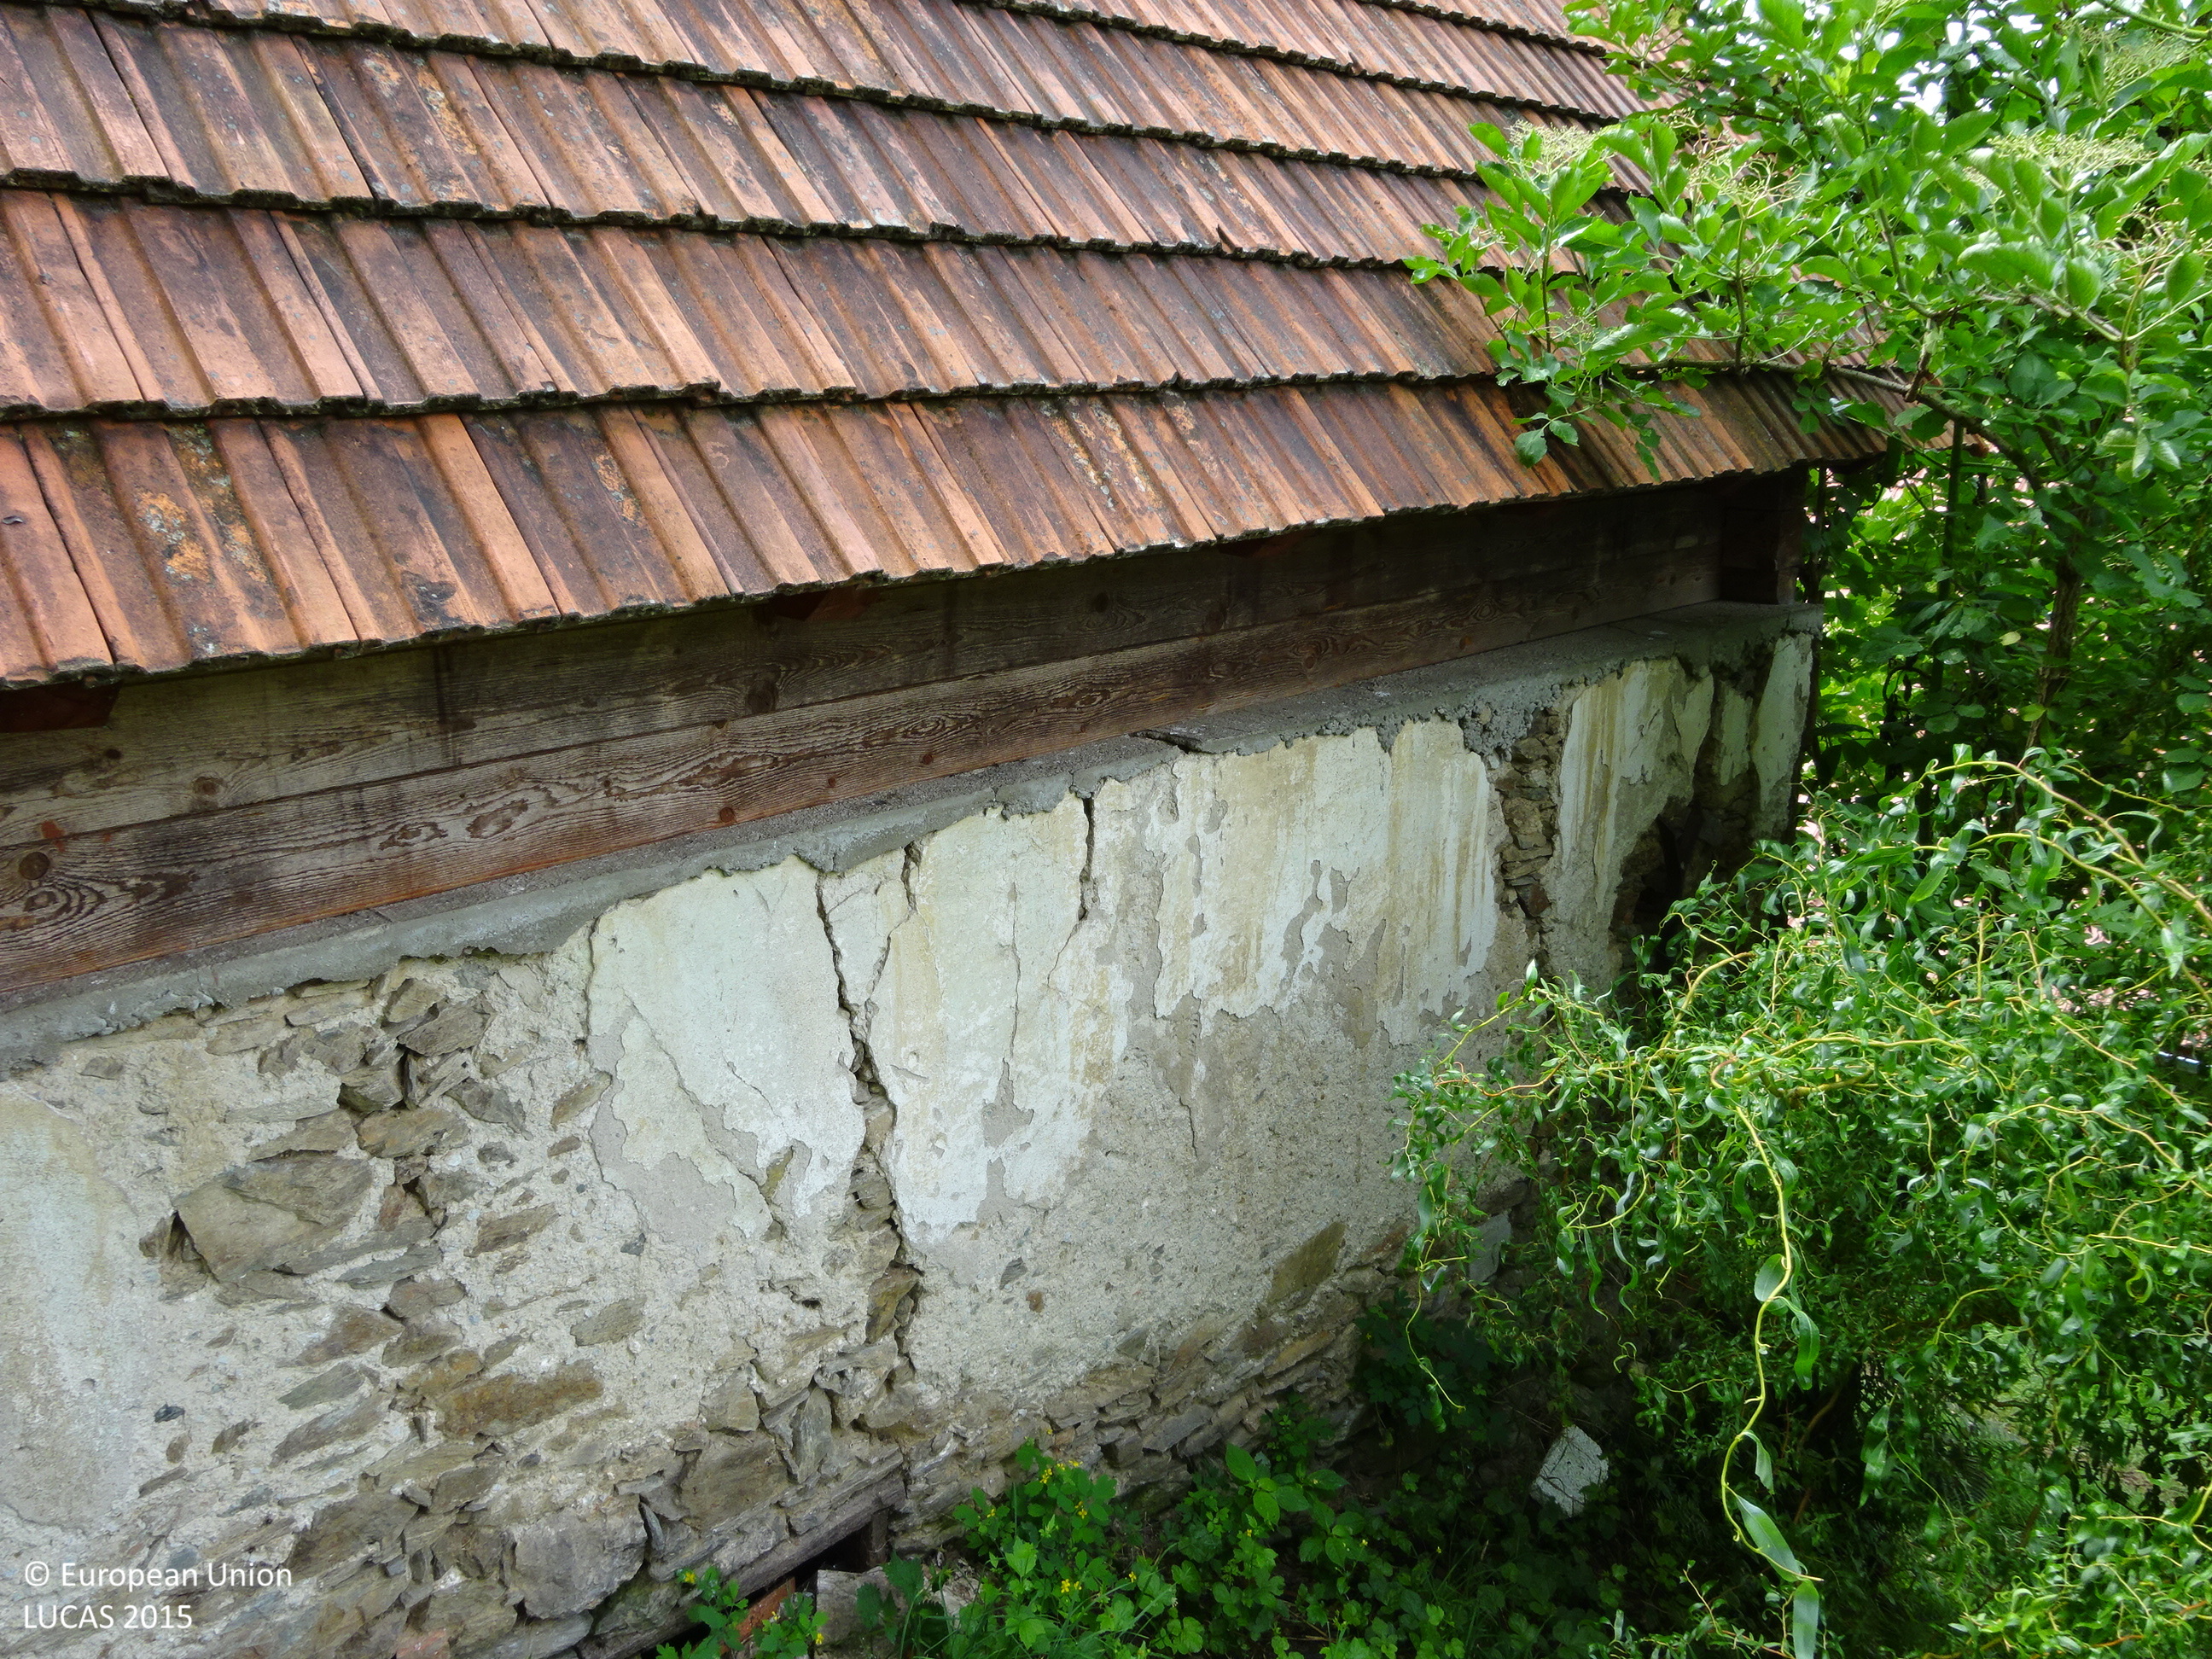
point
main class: Cropland
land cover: Apple fruit
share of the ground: 25 - 50 %
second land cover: Grassland without tree/shrub cover
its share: > 75 %
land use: Kitchen garden
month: June
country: AT
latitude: 46.7726
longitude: 15.4339
